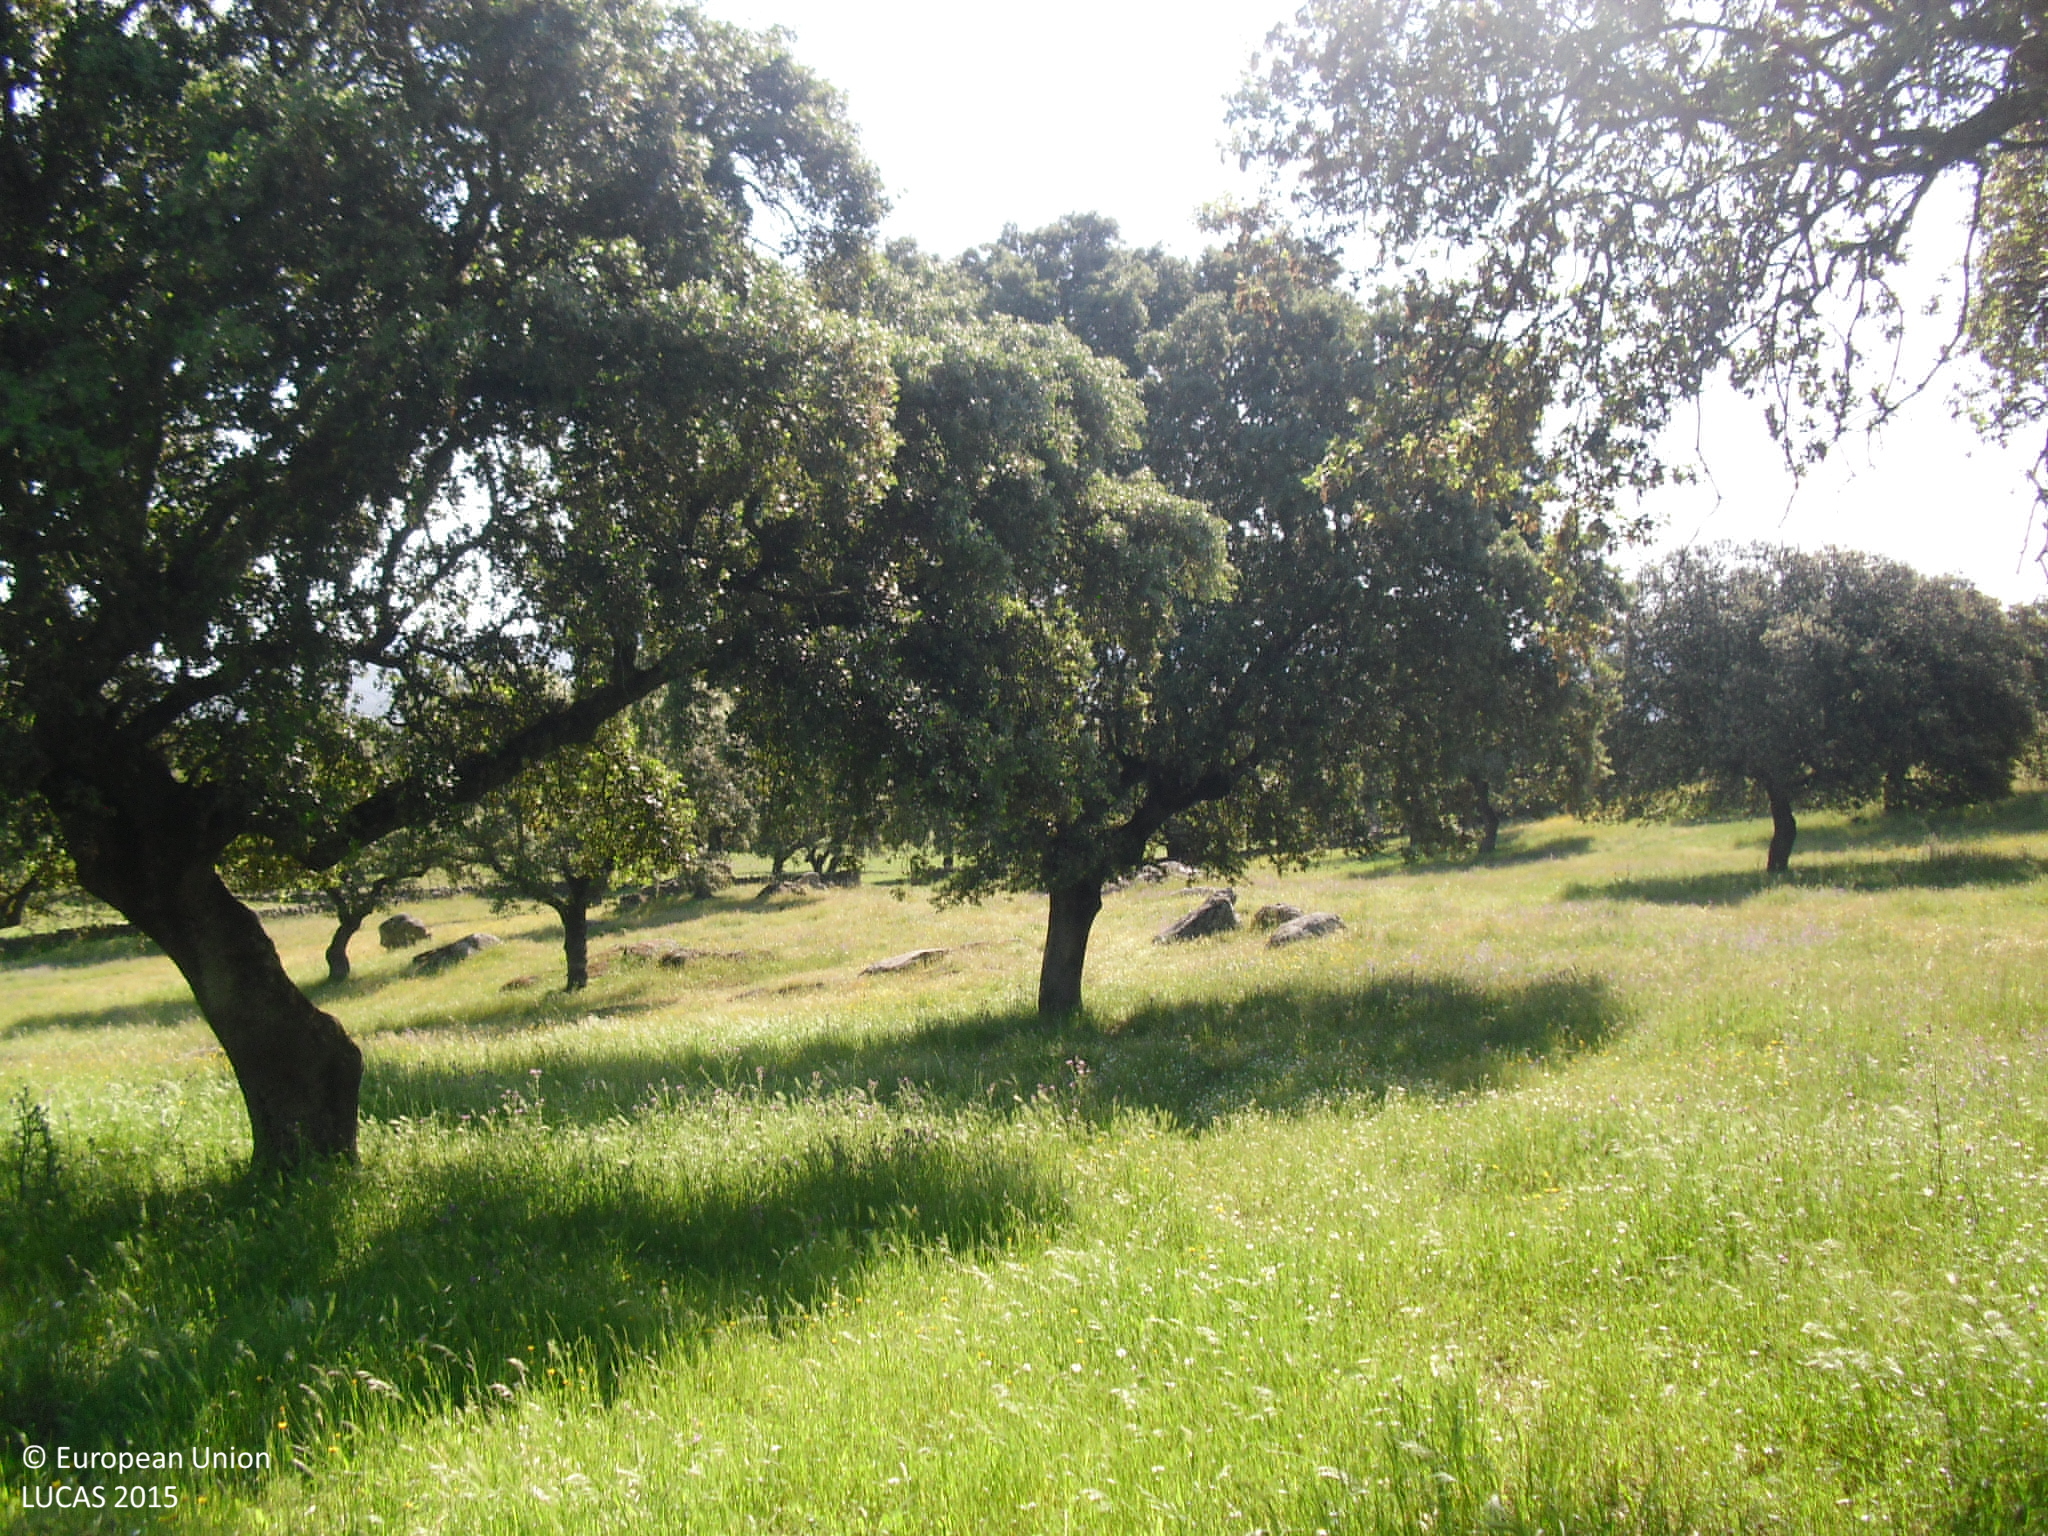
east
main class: Woodland
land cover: Broadleaved woodland
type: broadleaved evergreen forest
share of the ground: 25 - 50 %
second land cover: Grassland without tree/shrub cover
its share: > 75 %
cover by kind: herbaceous plants 55 %, broadleaved forest trees 45 %
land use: Forestry
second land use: Agriculture (excluding fallow land and kitchen gardens)
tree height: > 5 m
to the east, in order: Broadleaved woodland; Grassland without tree/shrub cover; Dry stone walls; Broadleaved woodland
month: May
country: ES
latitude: 39.3496
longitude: -5.7778
